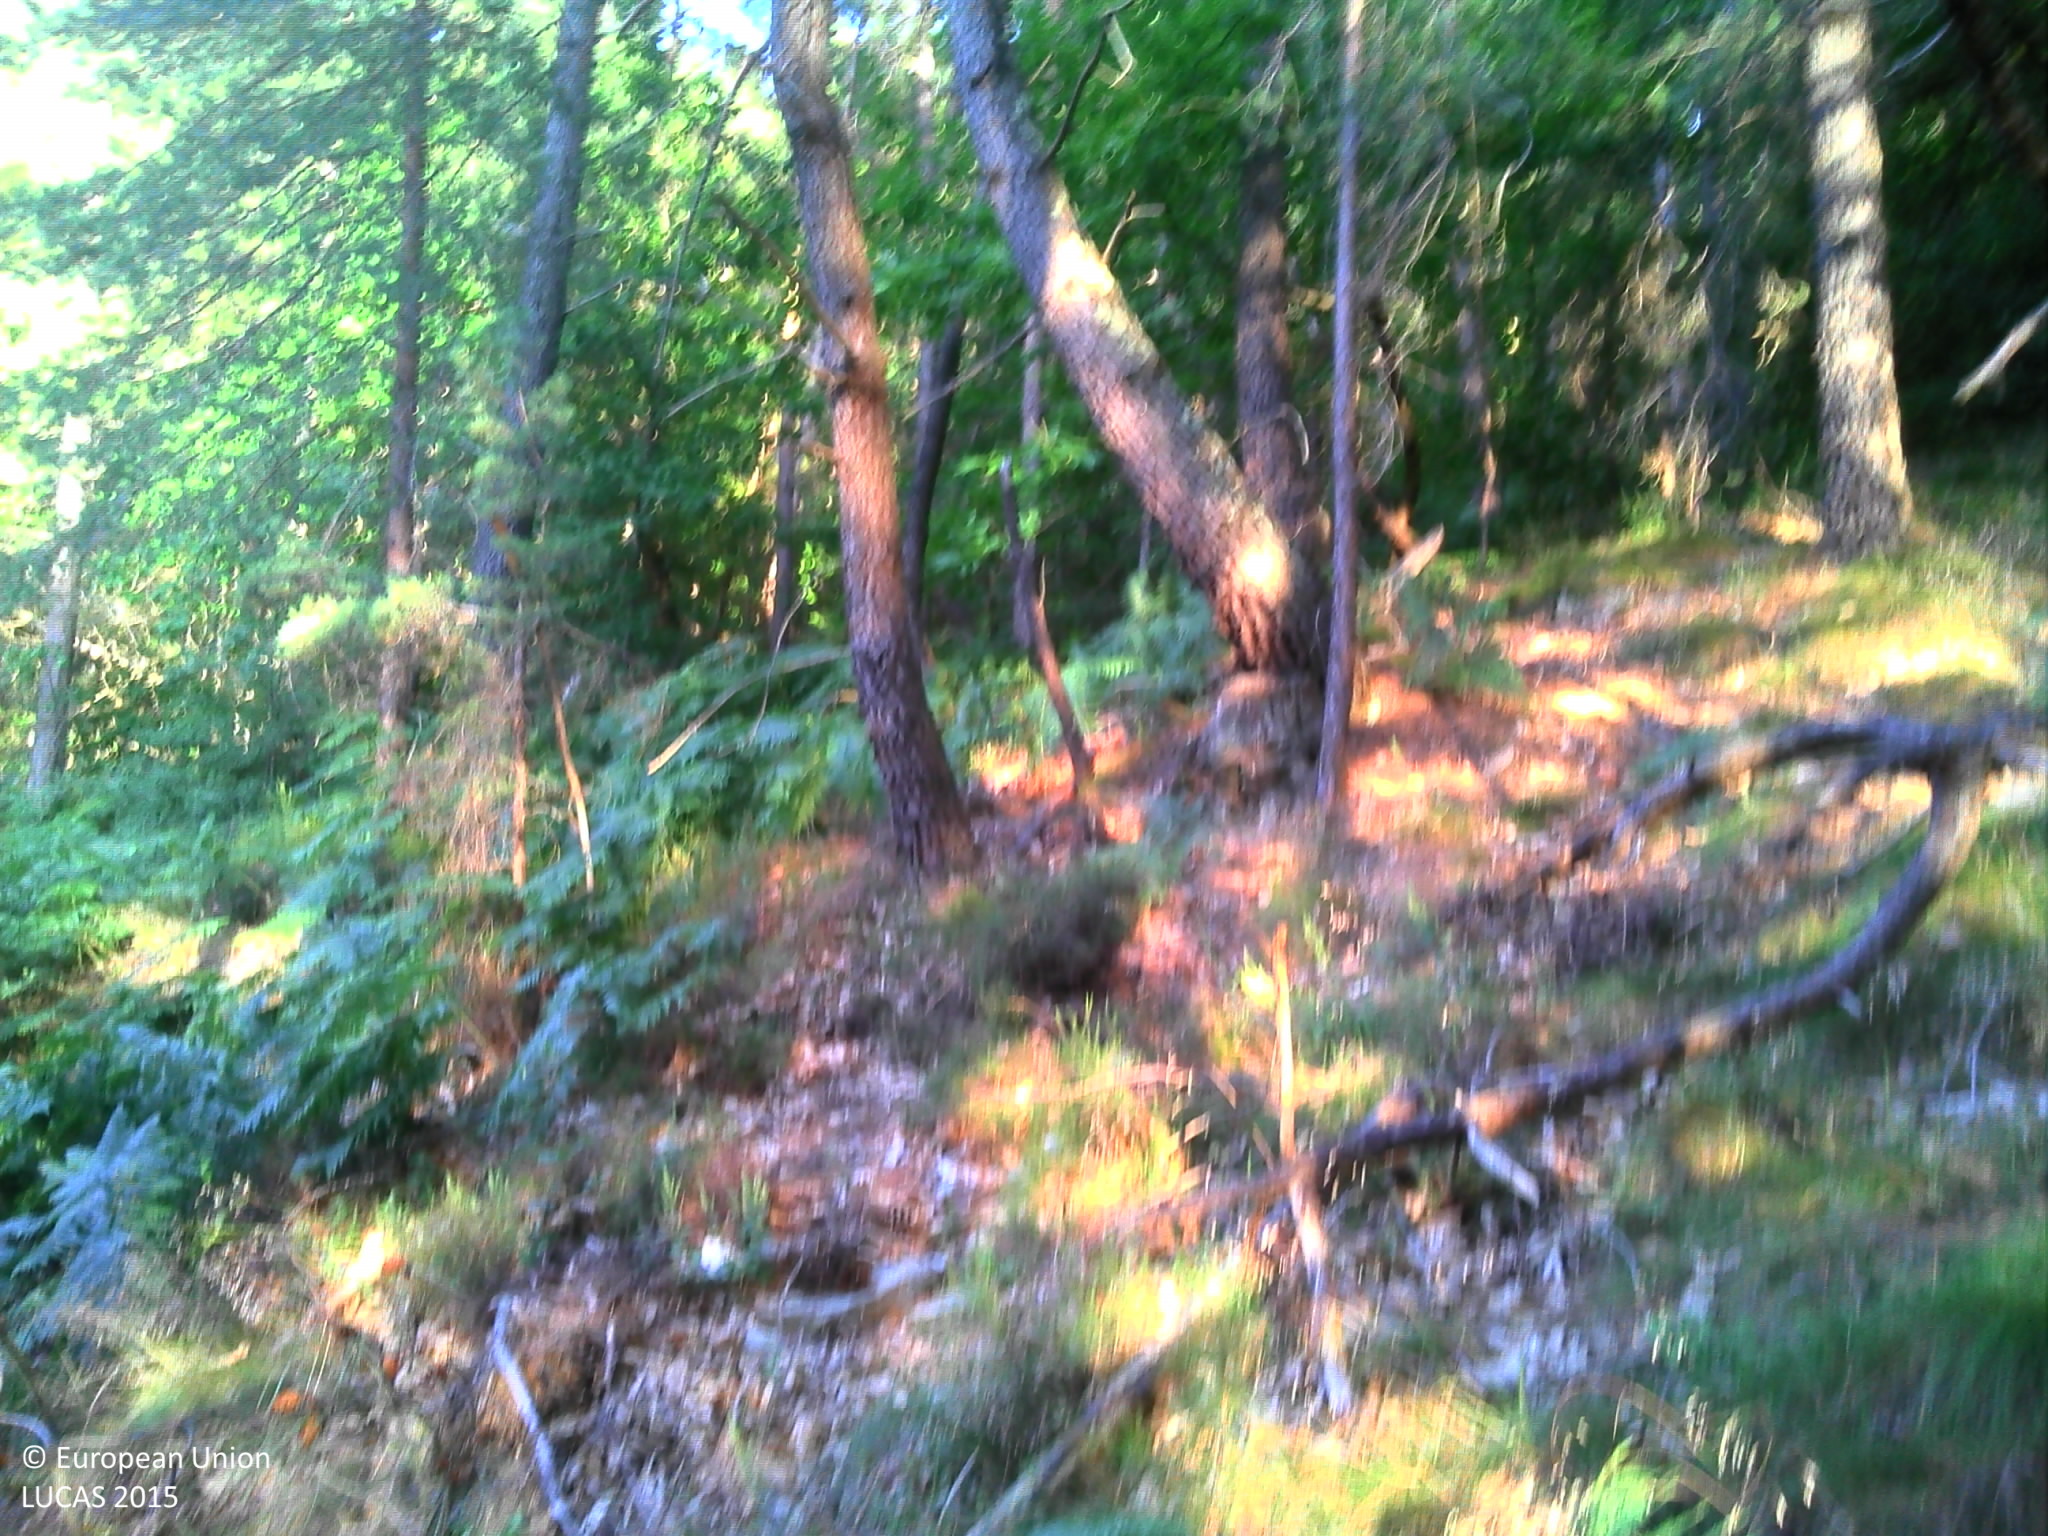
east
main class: Woodland
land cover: Pine dominated mixed woodland
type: coniferous forest of the mediterranean region
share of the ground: > 75 %
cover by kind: broadleaved forest trees 75 %, coniferous forest trees 25 %
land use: Forestry
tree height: > 5 m
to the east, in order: Pine dominated mixed woodland; Pine dominated coniferous woodland; Electric lines; Pine dominated coniferous woodland; Paved roads, cycling and walking lanes
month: June
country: FR
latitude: 44.2633
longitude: 3.9315
